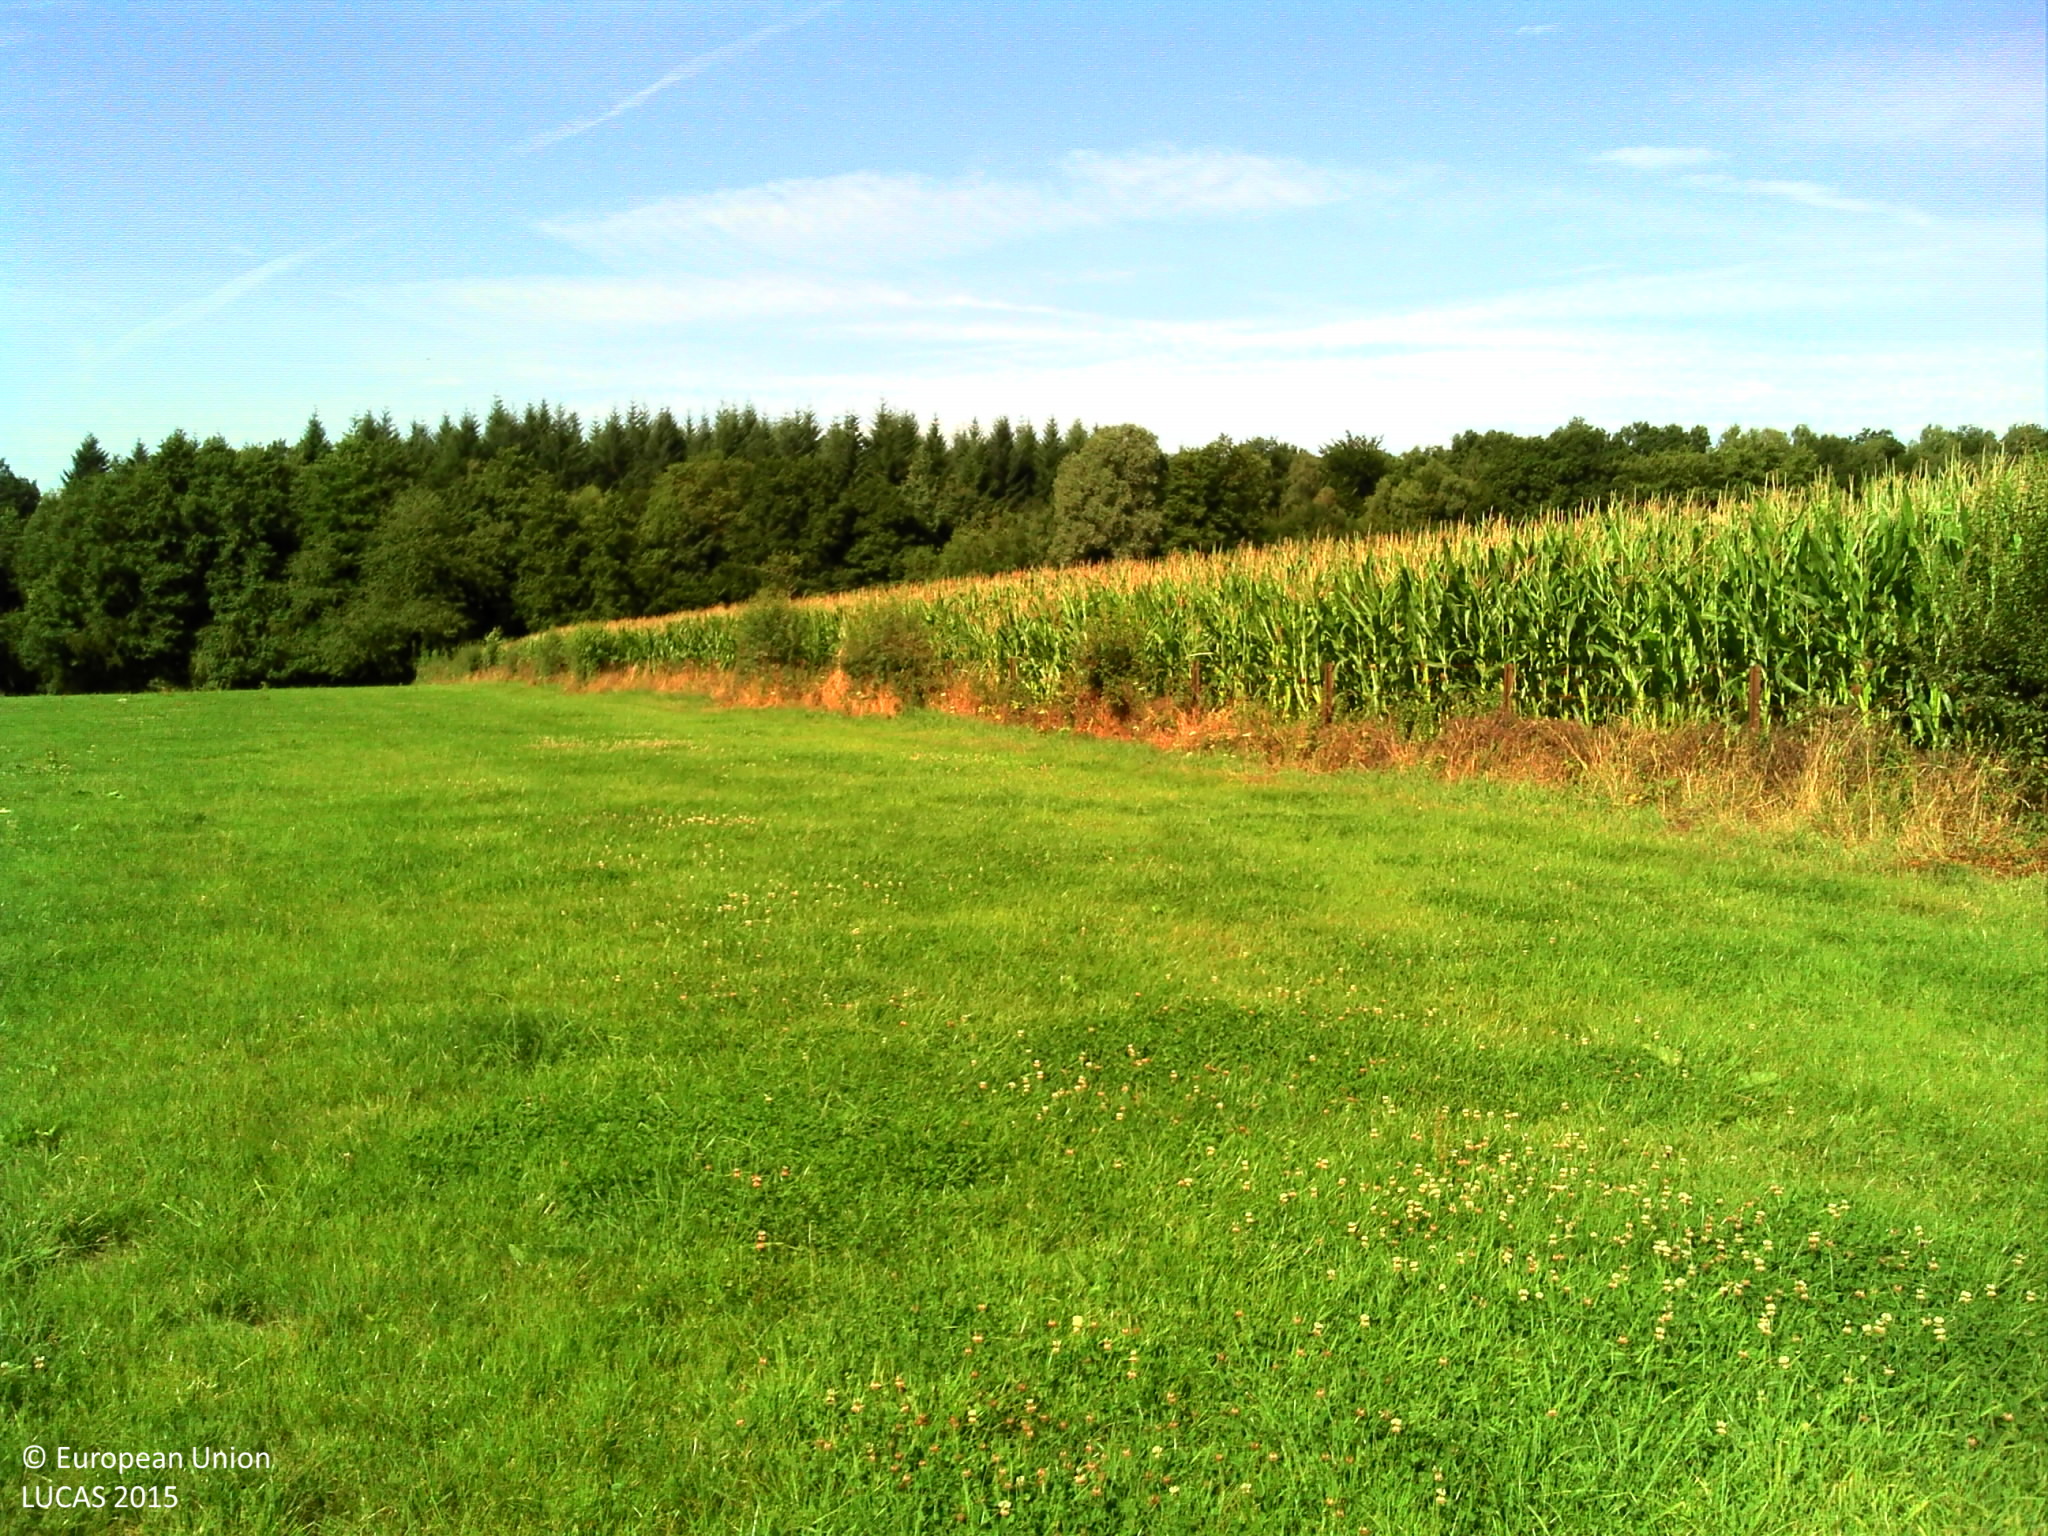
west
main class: Grassland
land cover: Grassland without tree/shrub cover
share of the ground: > 75 %
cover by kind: herbaceous plants 100 %
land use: Agriculture (excluding fallow land and kitchen gardens)
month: August
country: FR
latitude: 50.1534
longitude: 4.0182
